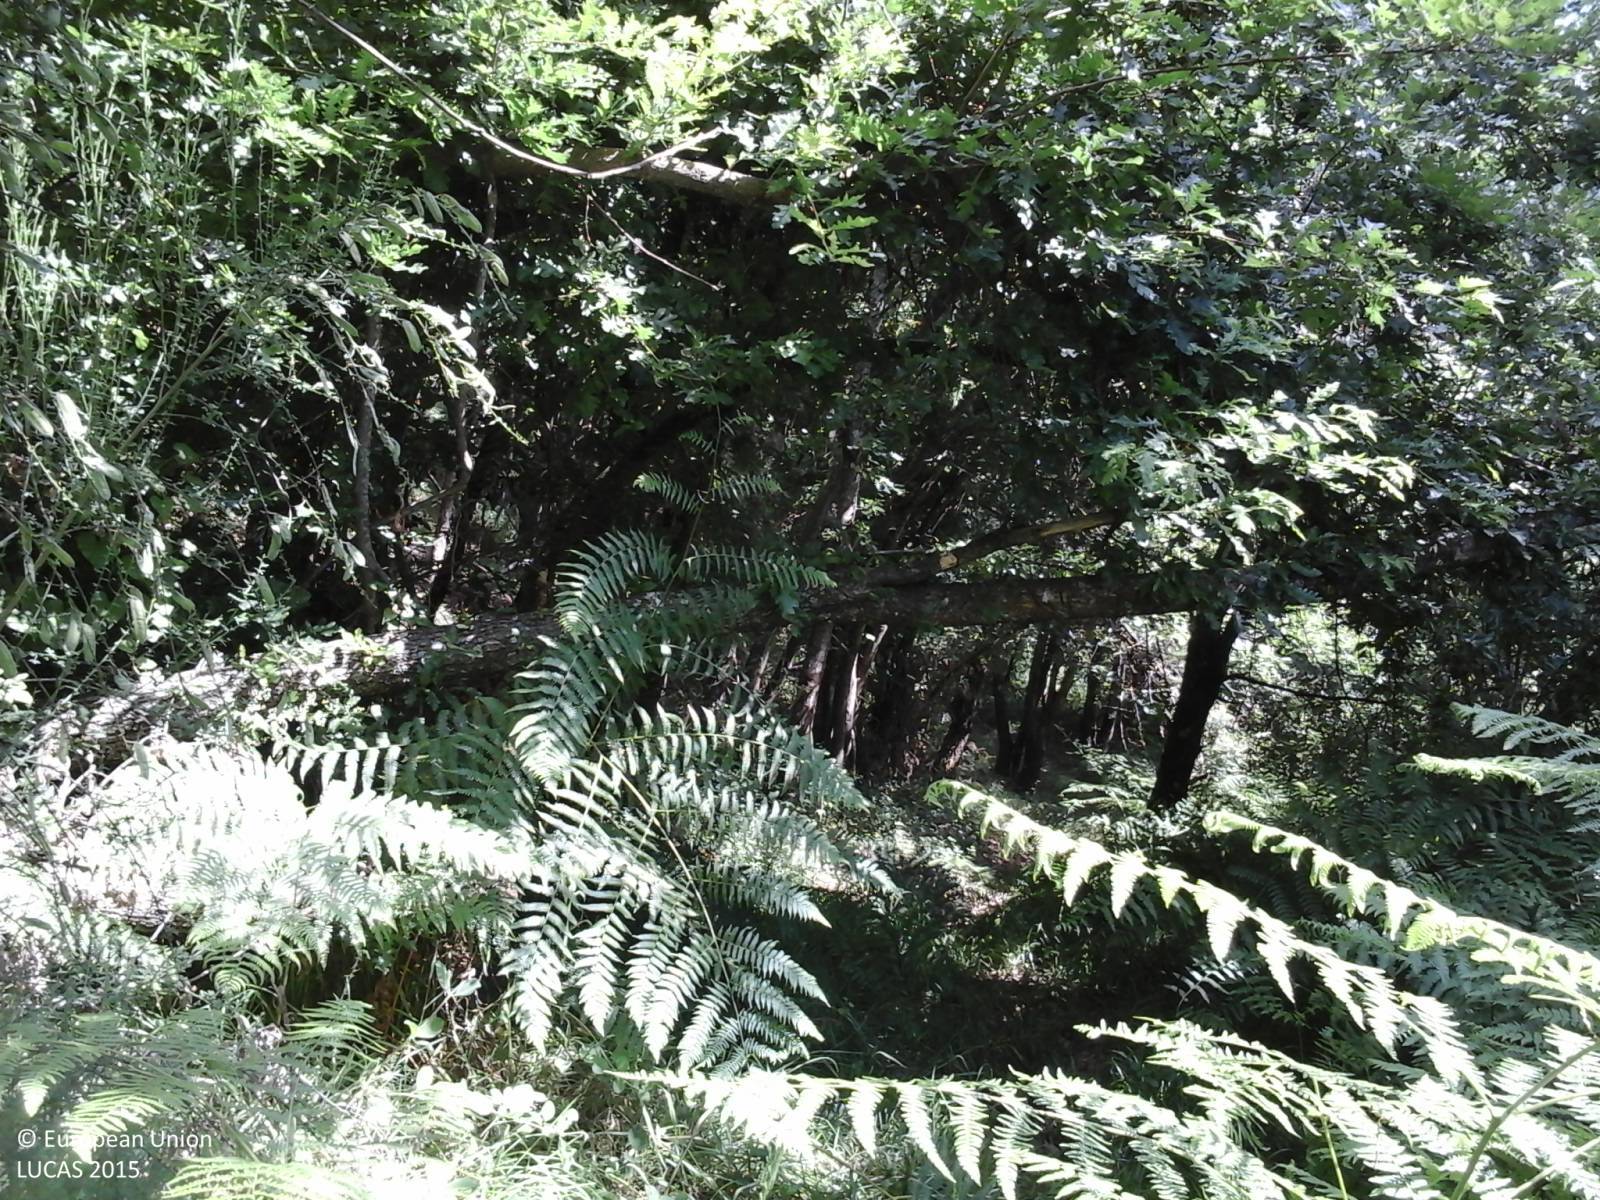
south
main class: Woodland
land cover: Broadleaved woodland
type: thermophilous deciduous forest
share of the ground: > 75 %
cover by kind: broadleaved forest trees 100 %
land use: Forestry
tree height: > 5 m
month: June
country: IT
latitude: 44.1878
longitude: 10.2871
